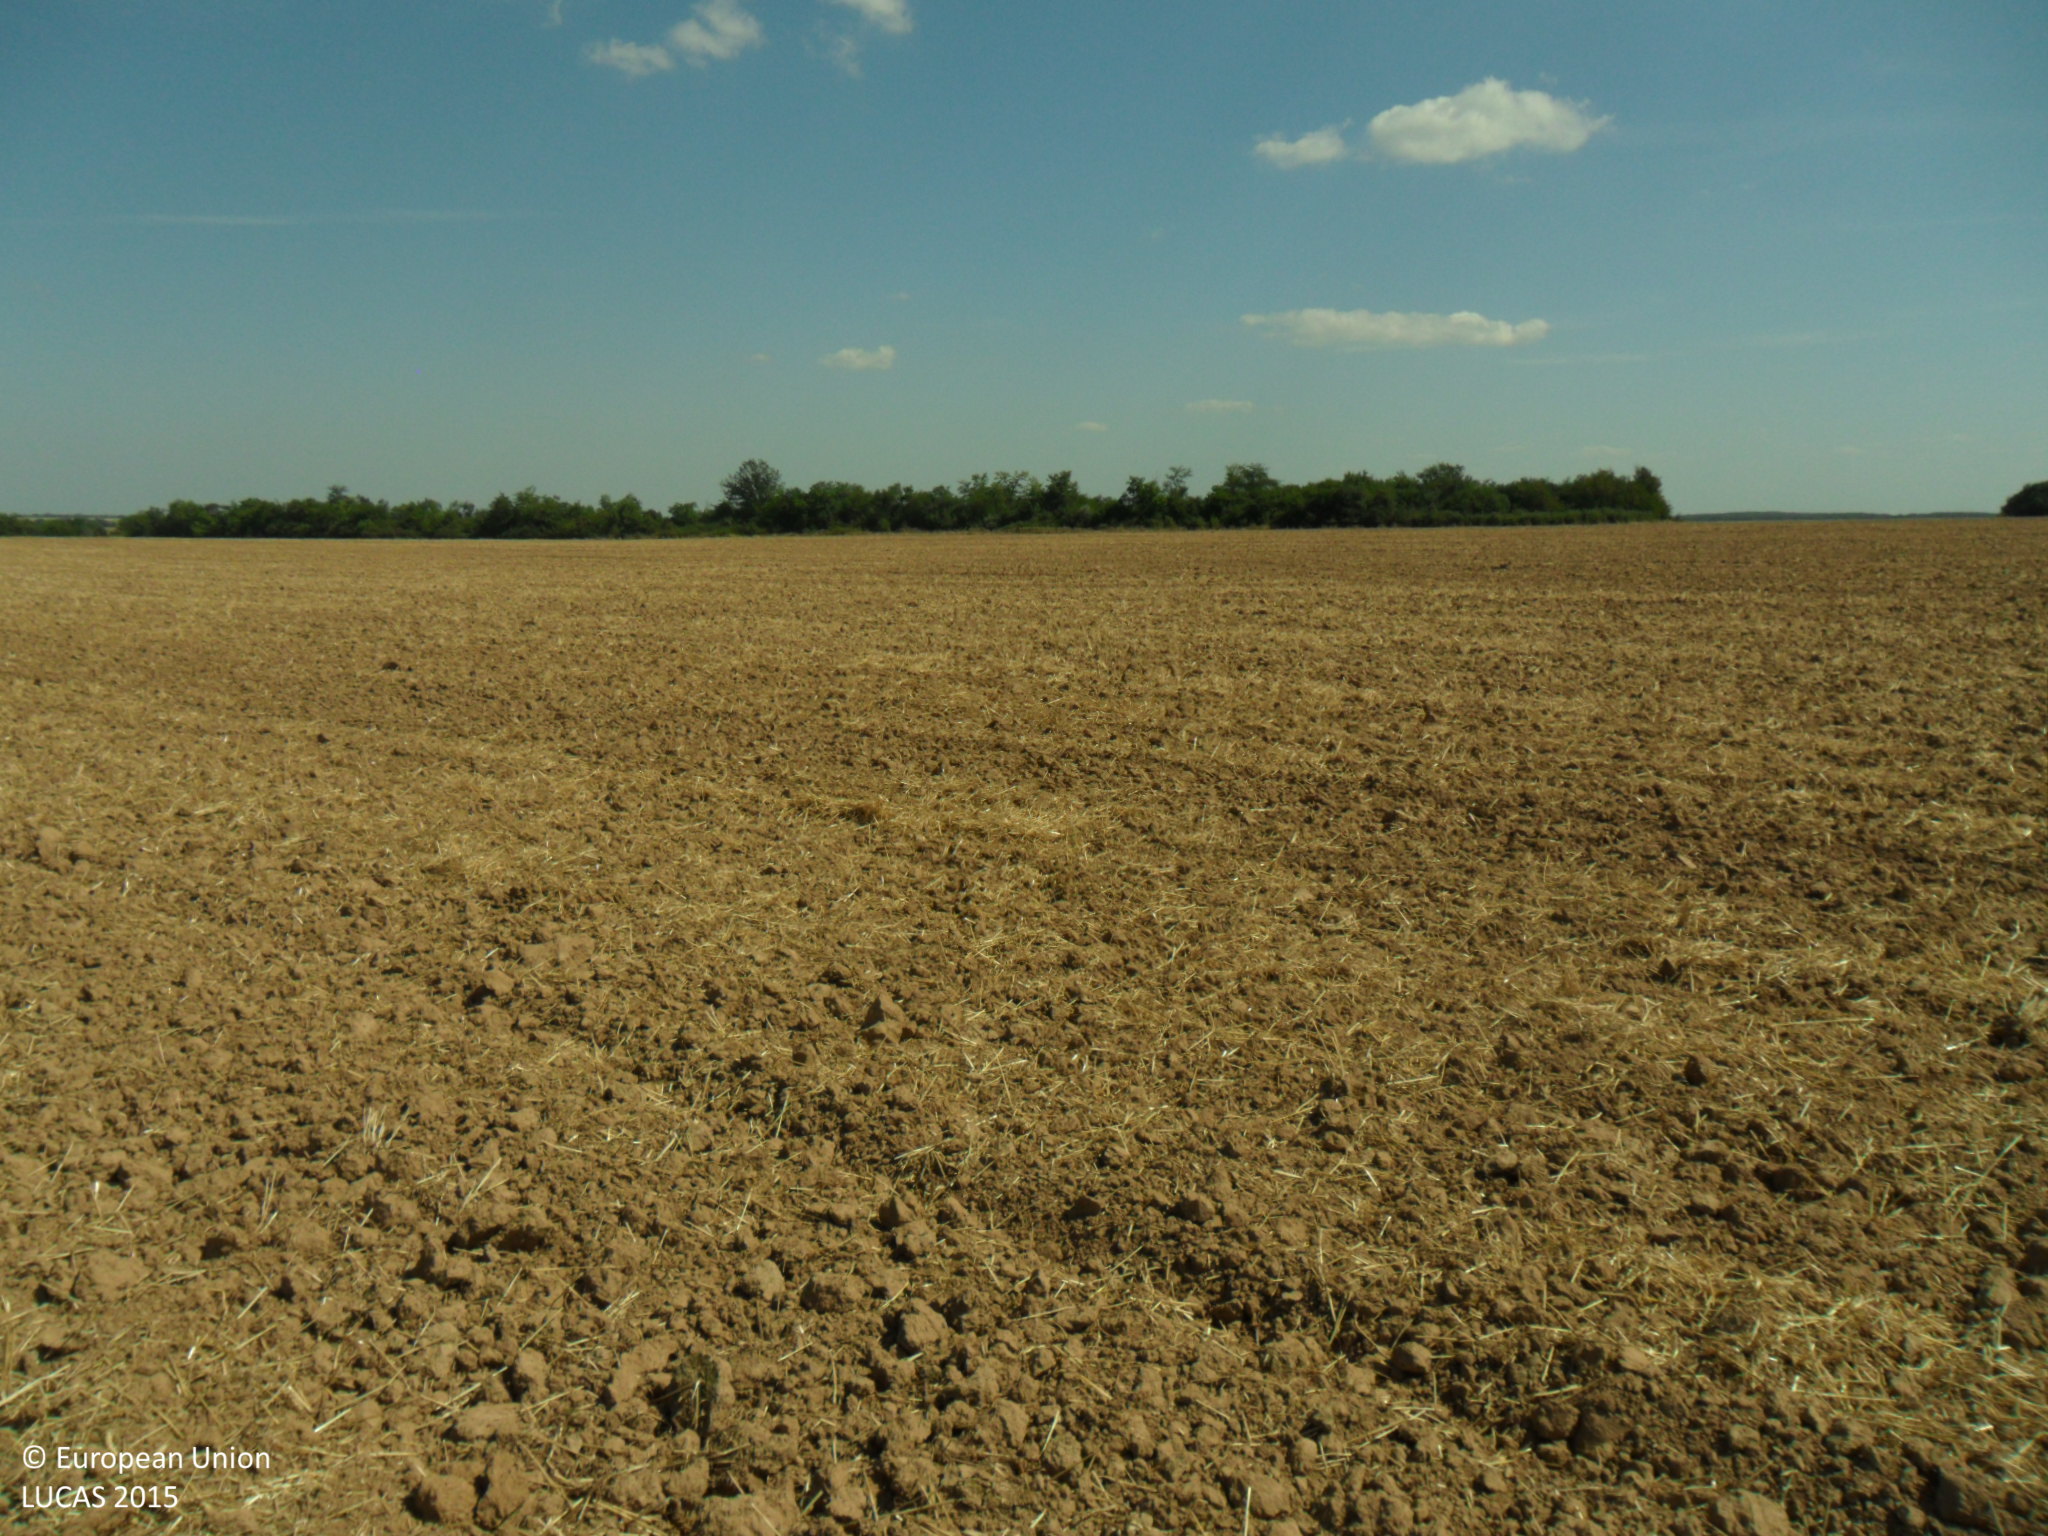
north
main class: Cropland
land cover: Common wheat
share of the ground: < 10 %
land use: Agriculture (excluding fallow land and kitchen gardens)
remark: Harvested field
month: August
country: BG
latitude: 43.5595
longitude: 26.7880
